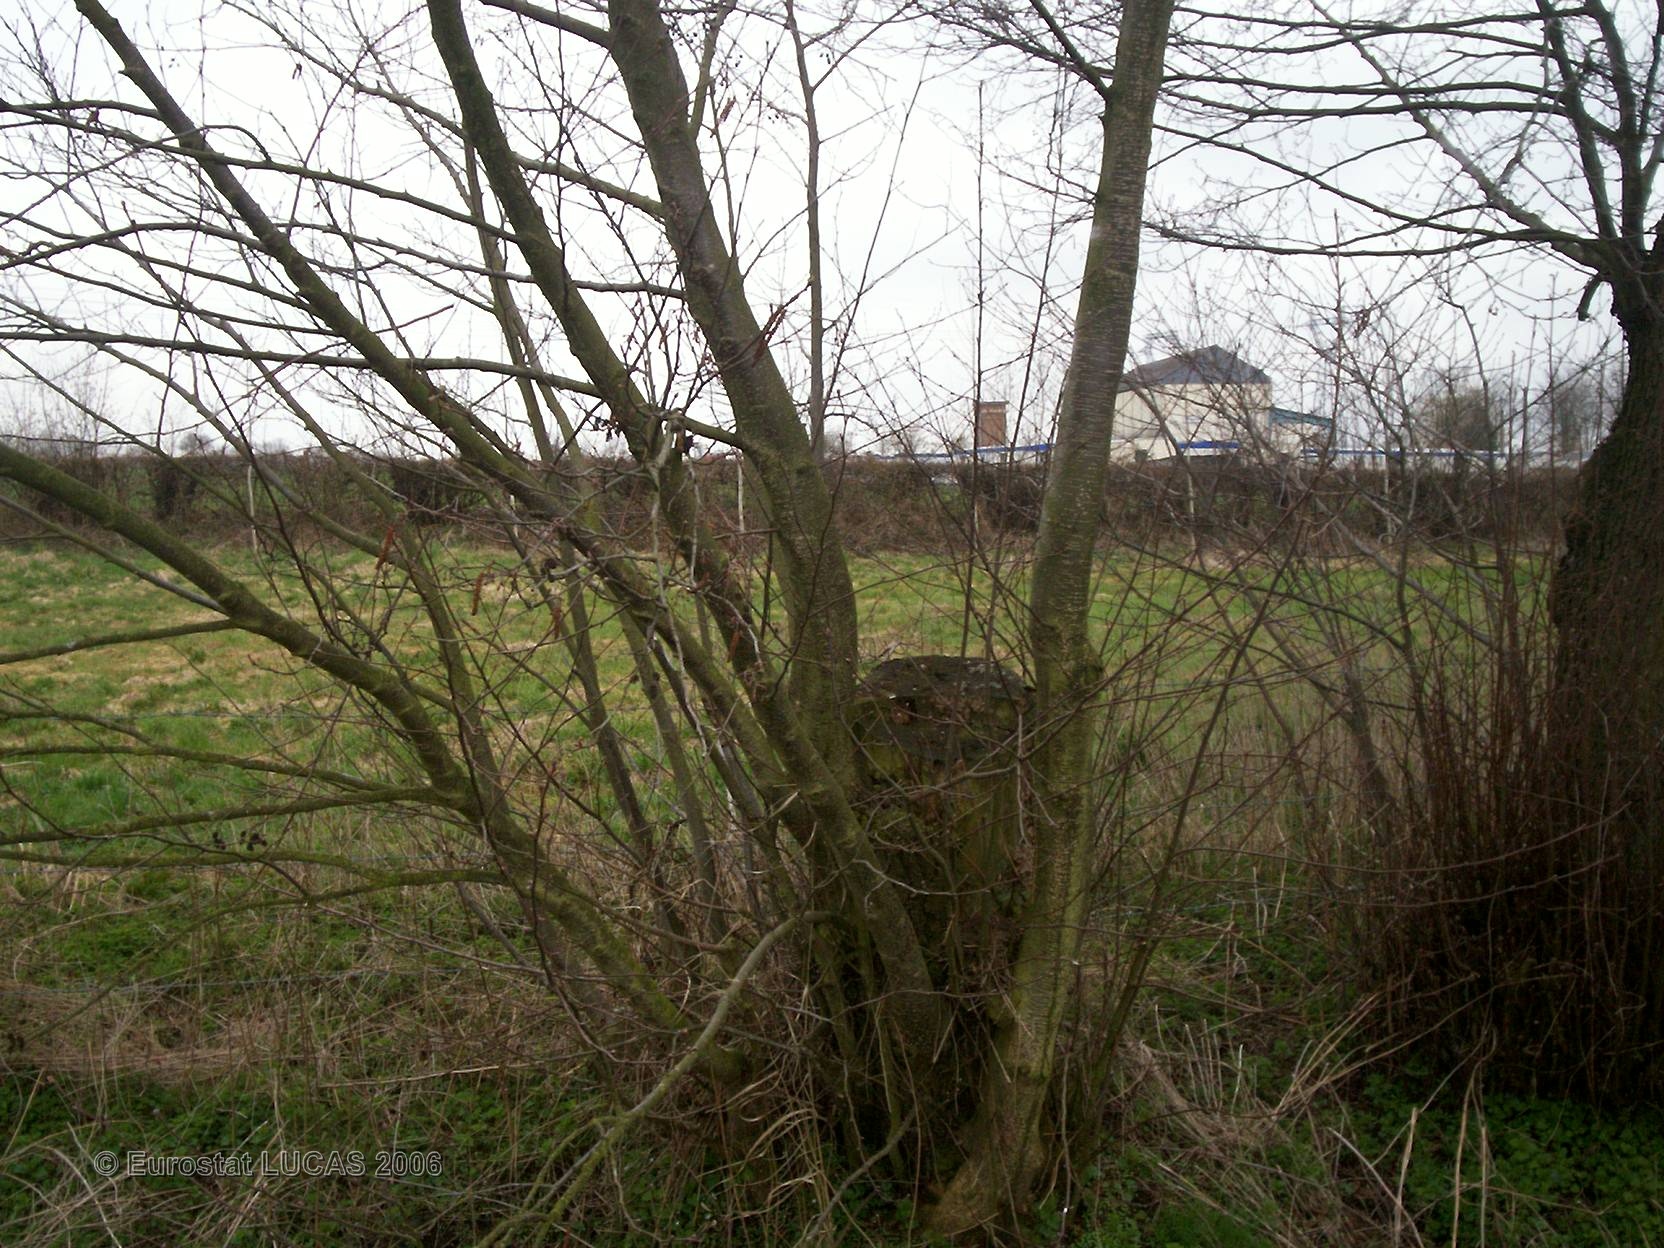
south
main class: Grassland
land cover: Grassland without tree/shrub cover
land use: Agriculture (excluding fallow land and kitchen gardens)
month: April
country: FR
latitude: 50.2817
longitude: 3.7203
